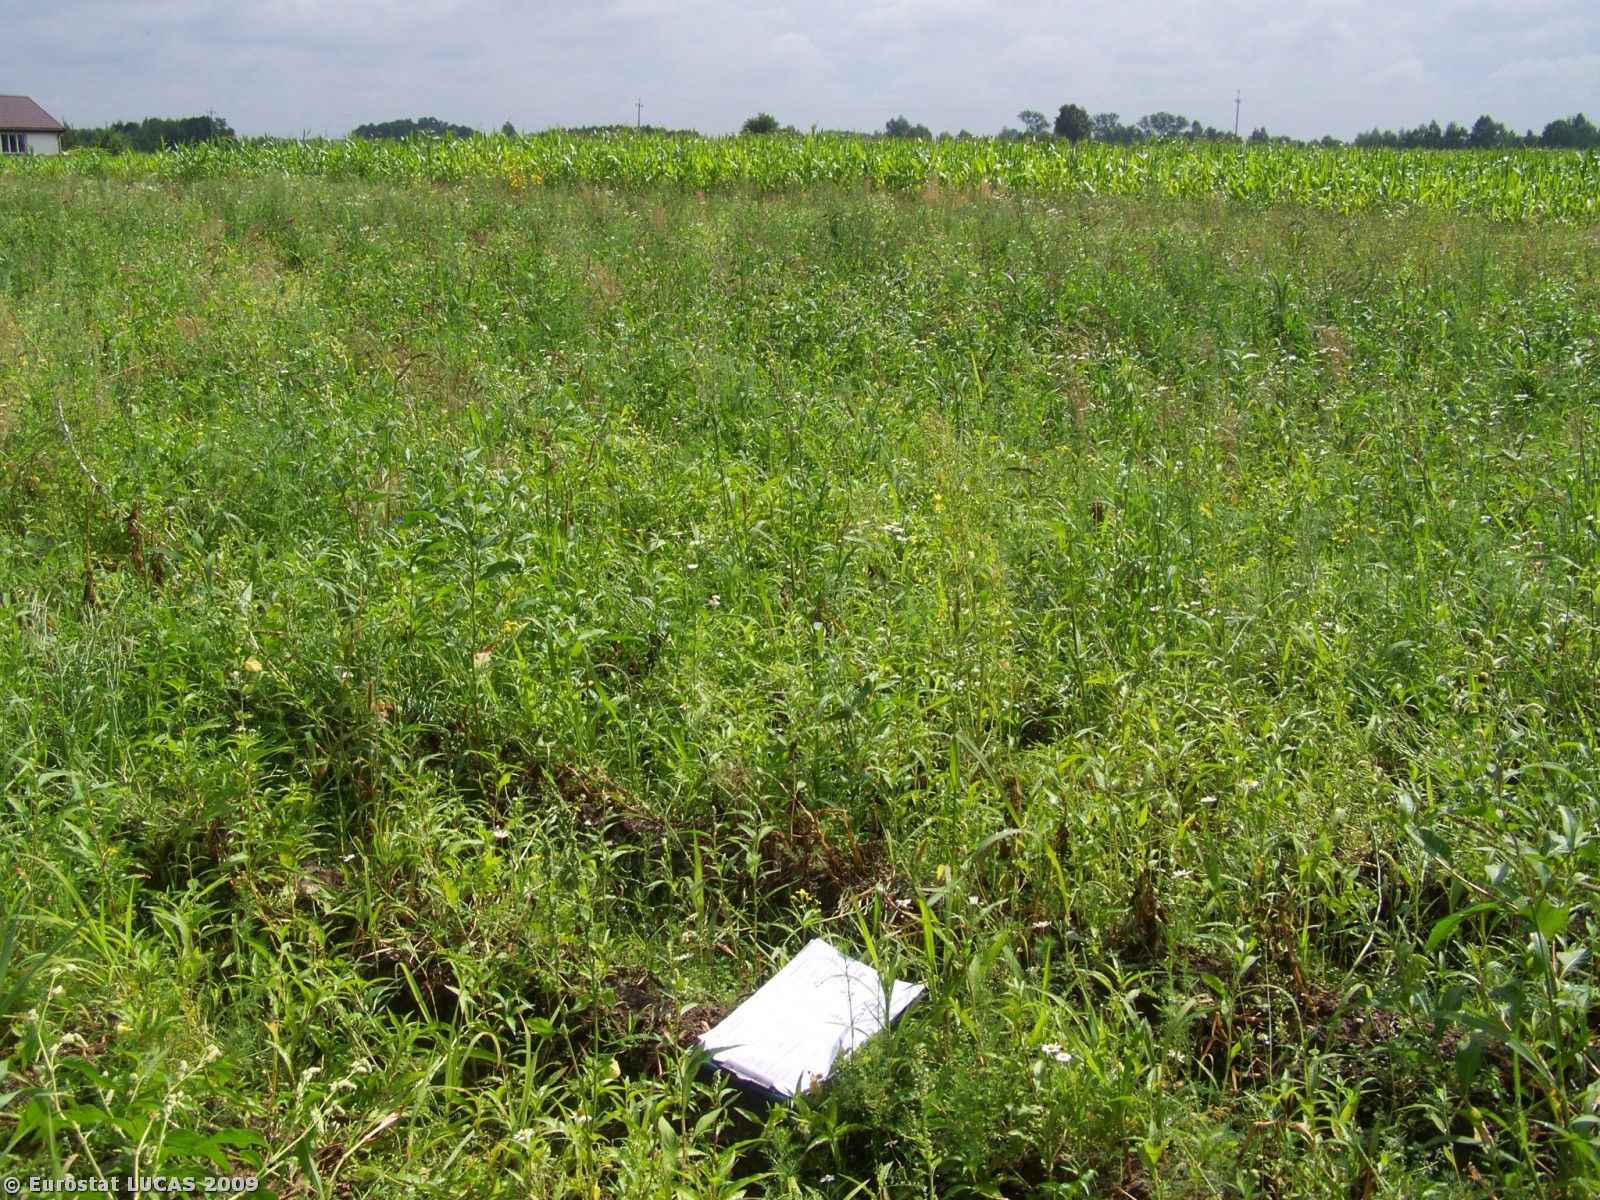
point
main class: Cropland
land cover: Potatoes
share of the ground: > 75 %
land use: Agriculture (excluding fallow land and kitchen gardens)
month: July
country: PL
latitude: 52.2631
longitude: 21.9403
